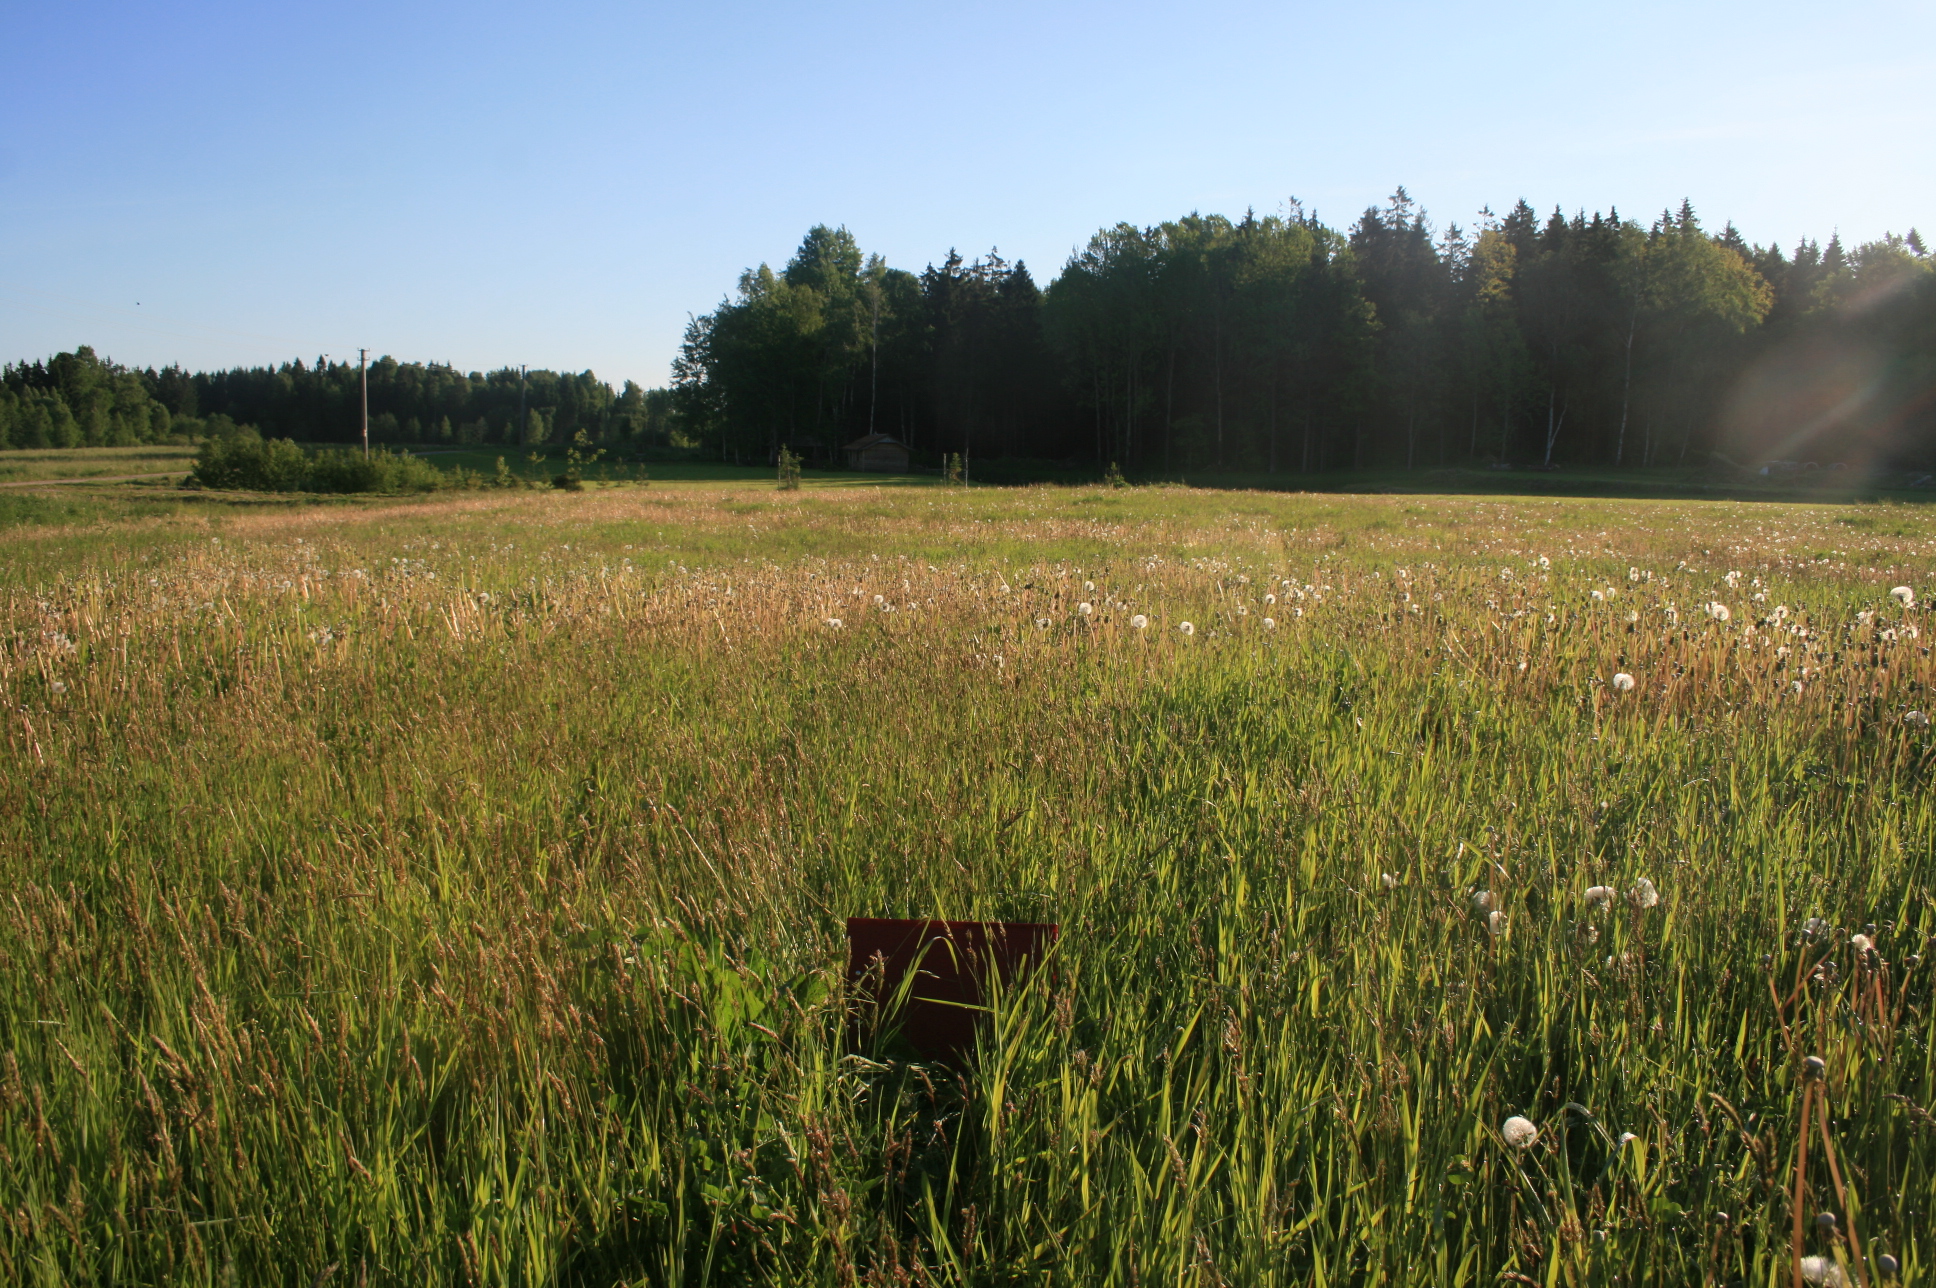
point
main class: Grassland
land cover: Grassland without tree/shrub cover
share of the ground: > 75 %
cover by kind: herbaceous plants 100 %
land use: Agriculture (excluding fallow land and kitchen gardens)
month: June
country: LT
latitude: 55.8984
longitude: 21.9658
